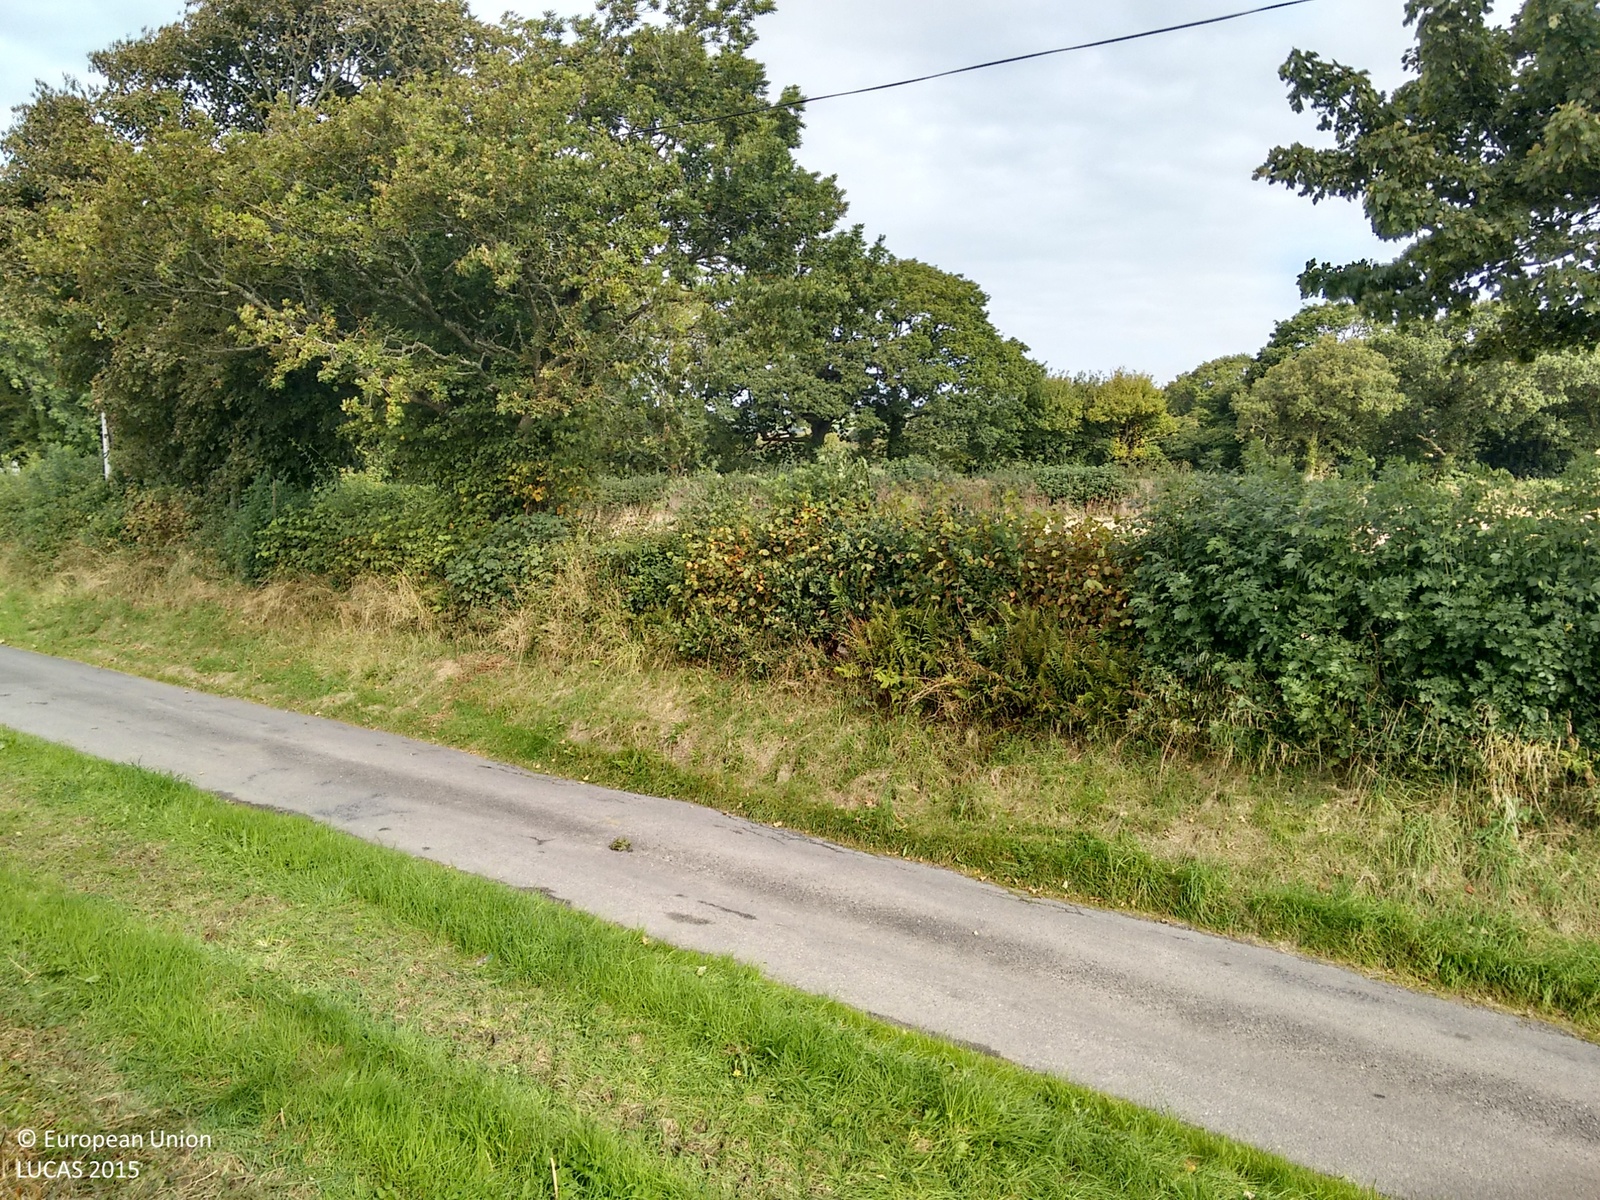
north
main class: Grassland
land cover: Grassland without tree/shrub cover
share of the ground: > 75 %
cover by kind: herbaceous plants 100 %
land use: Agriculture (excluding fallow land and kitchen gardens)
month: September
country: GB
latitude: 52.0582
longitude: -4.5604
